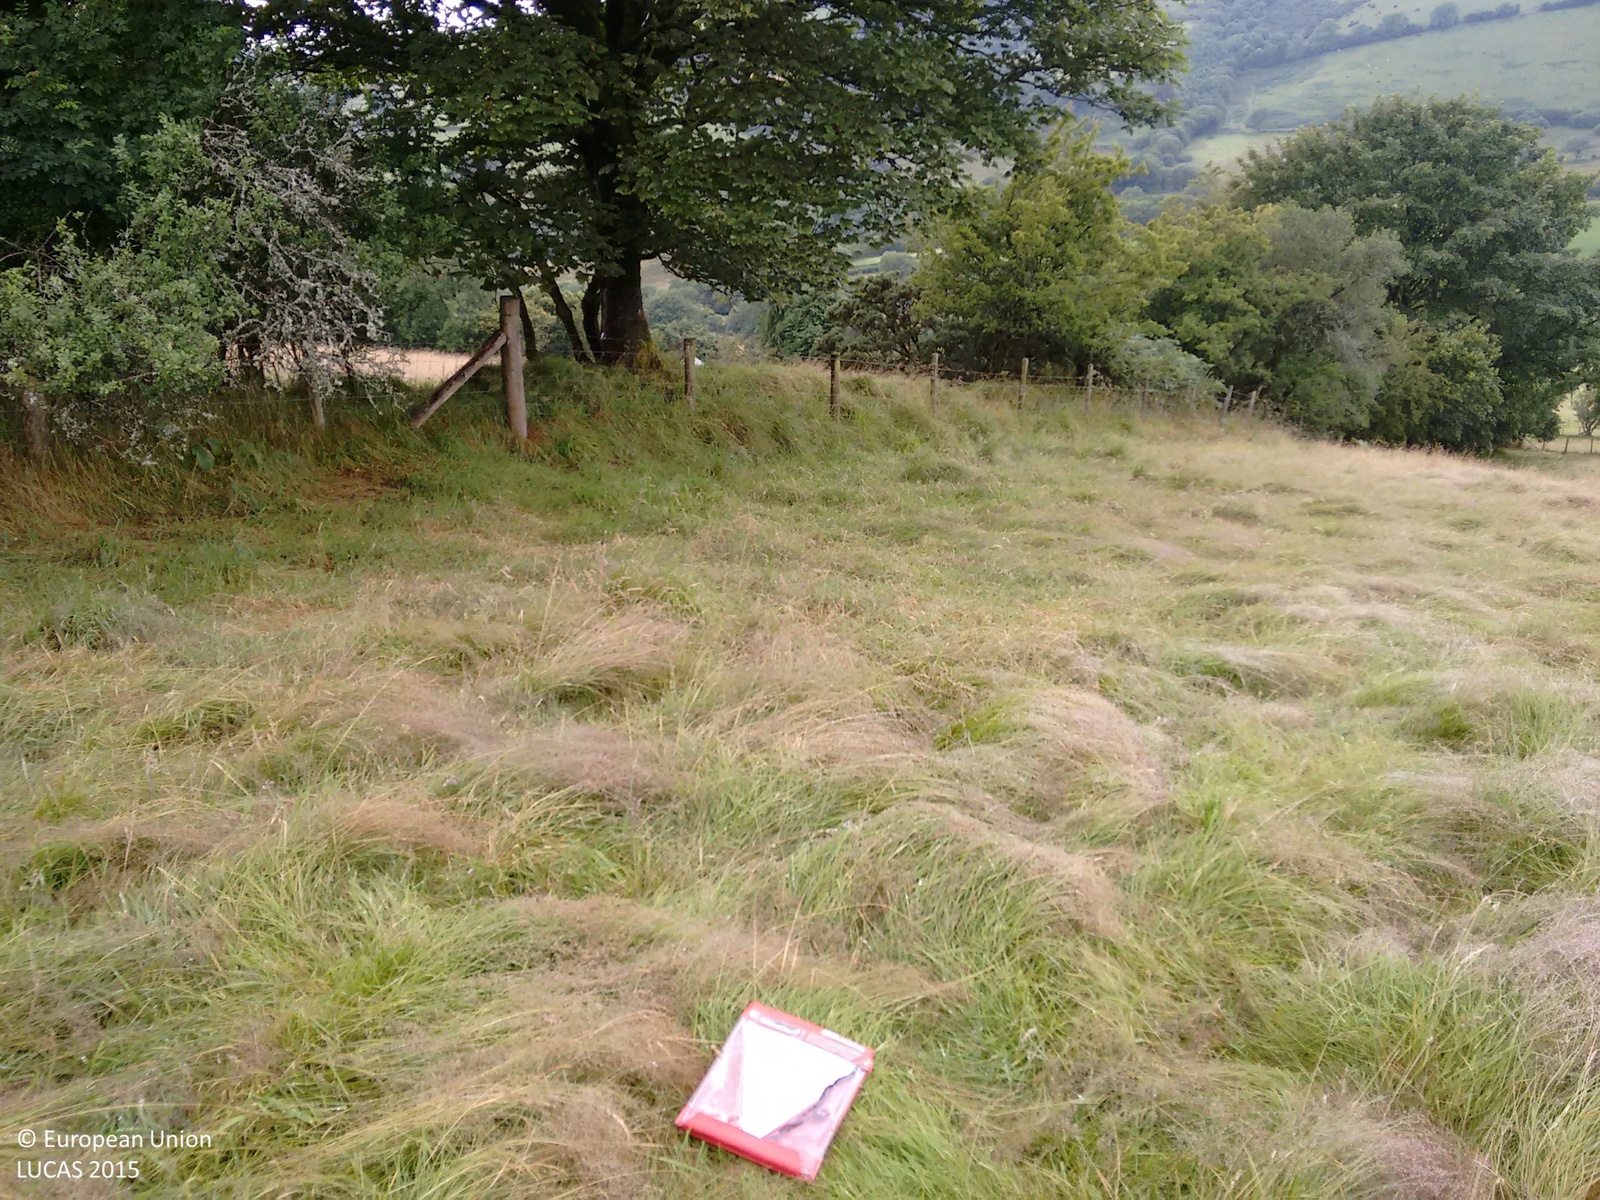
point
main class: Grassland
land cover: Grassland without tree/shrub cover
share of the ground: > 75 %
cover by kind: herbaceous plants 100 %
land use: Agriculture (excluding fallow land and kitchen gardens)
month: August
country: GB
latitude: 51.9386
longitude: -4.0451
